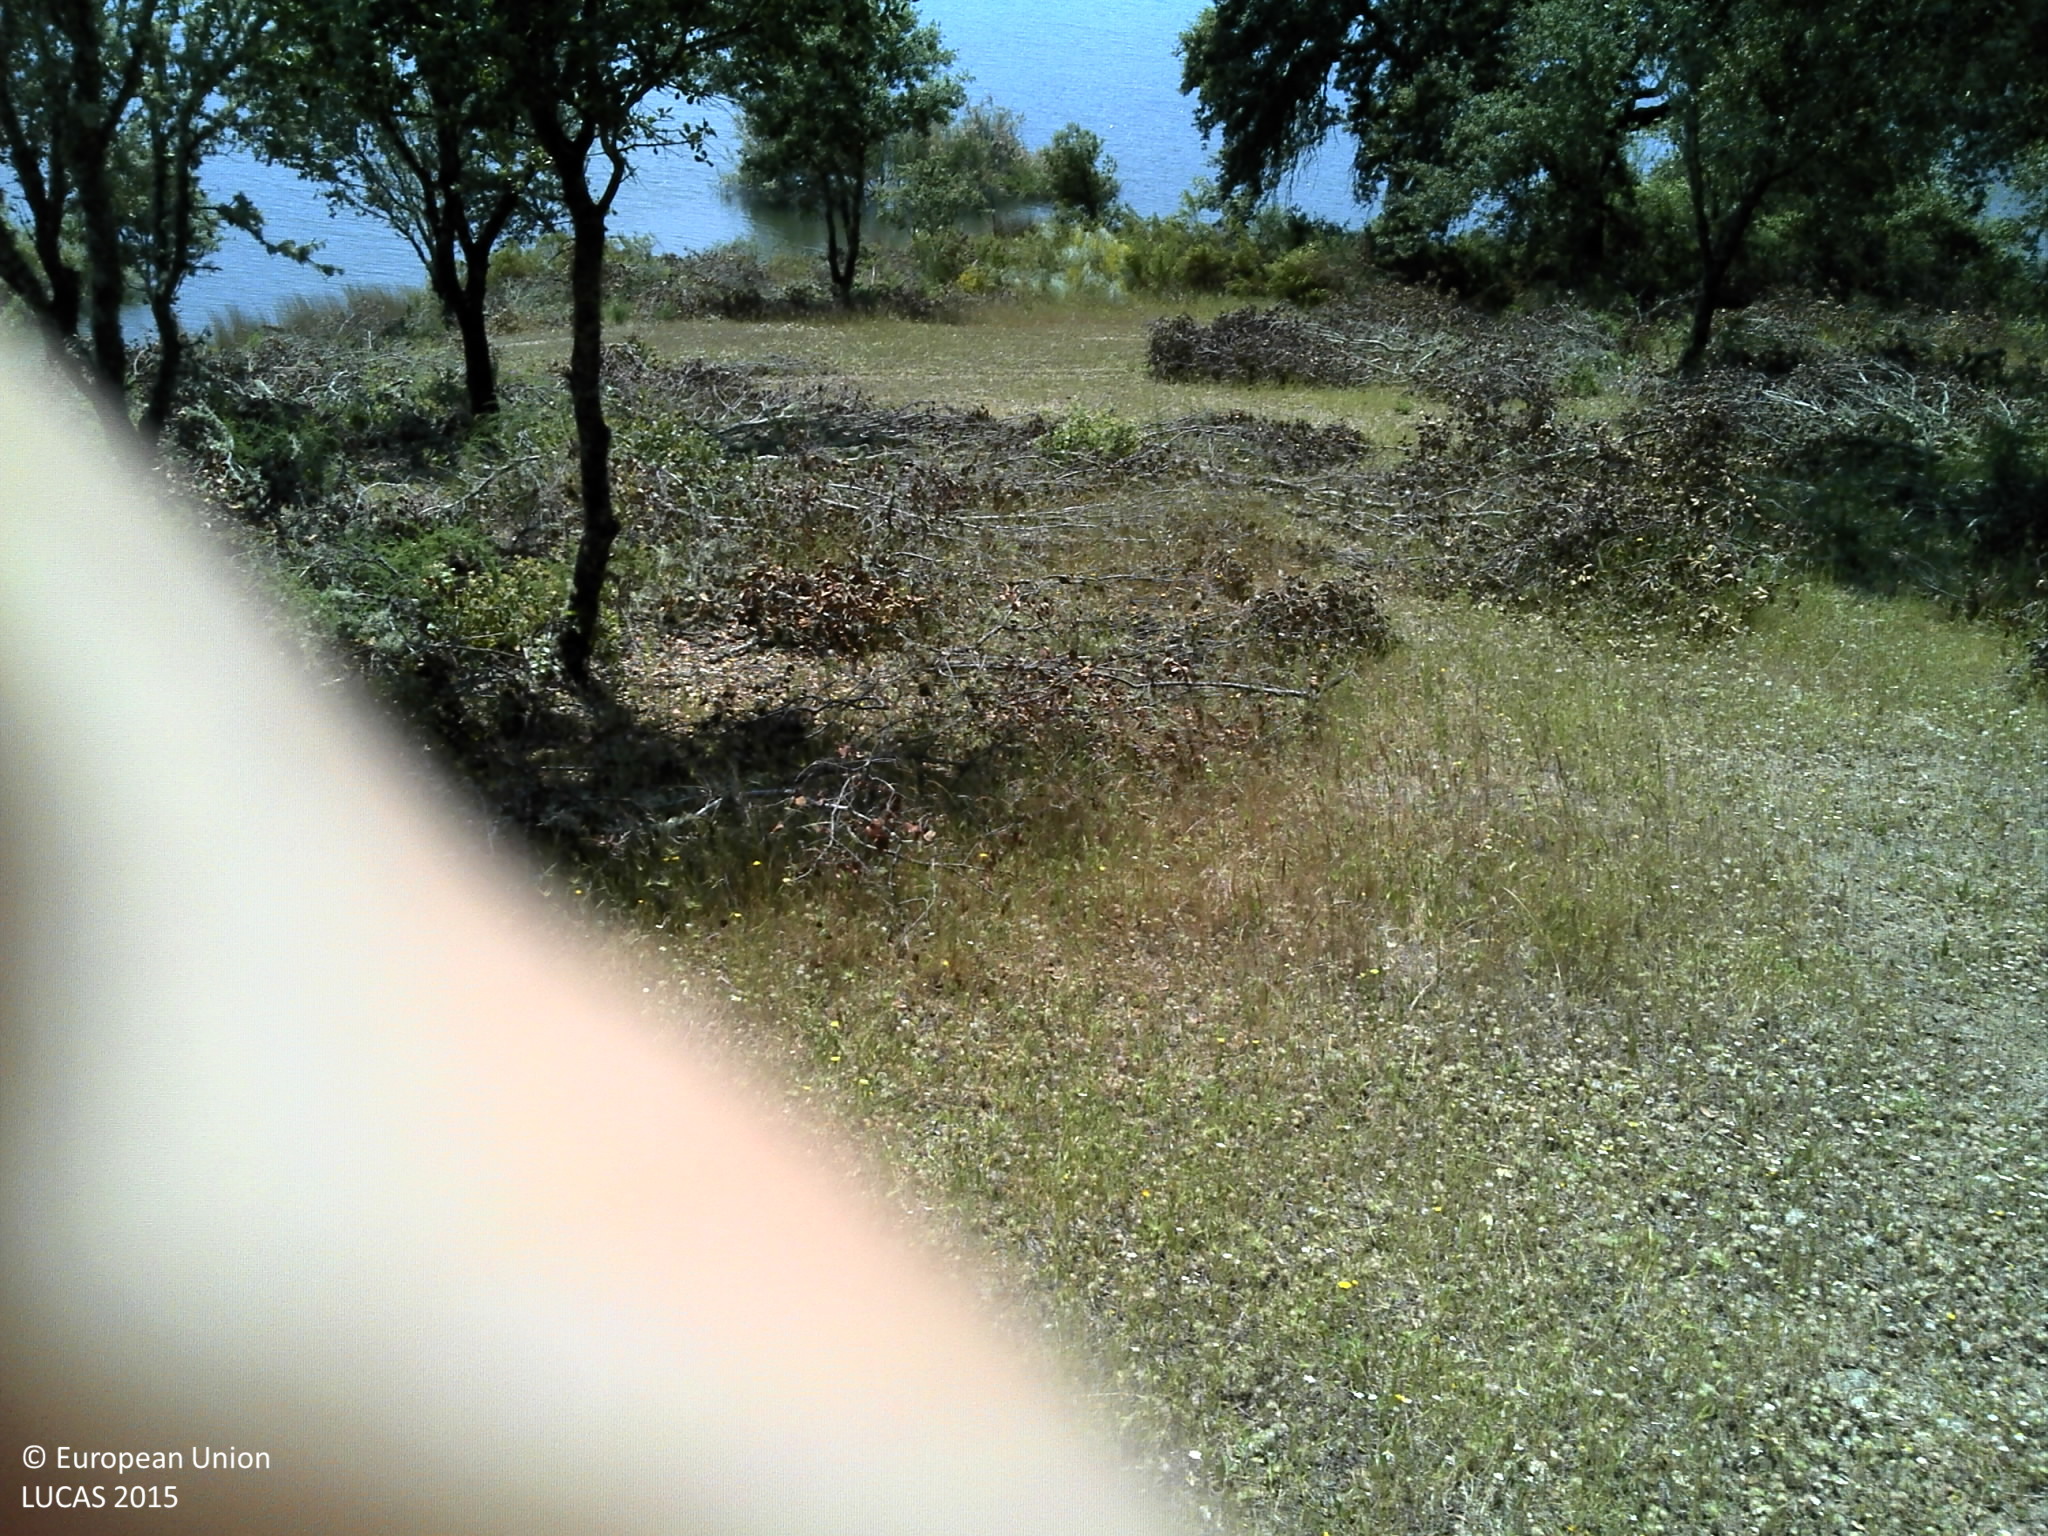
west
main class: Woodland
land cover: Broadleaved woodland
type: broadleaved evergreen forest
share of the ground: 50 - 75 %
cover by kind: broadleaved forest trees 60 %, herbaceous plants 20 %, consolidated bare surface 20 %
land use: Forestry
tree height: > 5 m
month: May
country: PT
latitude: 39.1148
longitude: -7.8474
